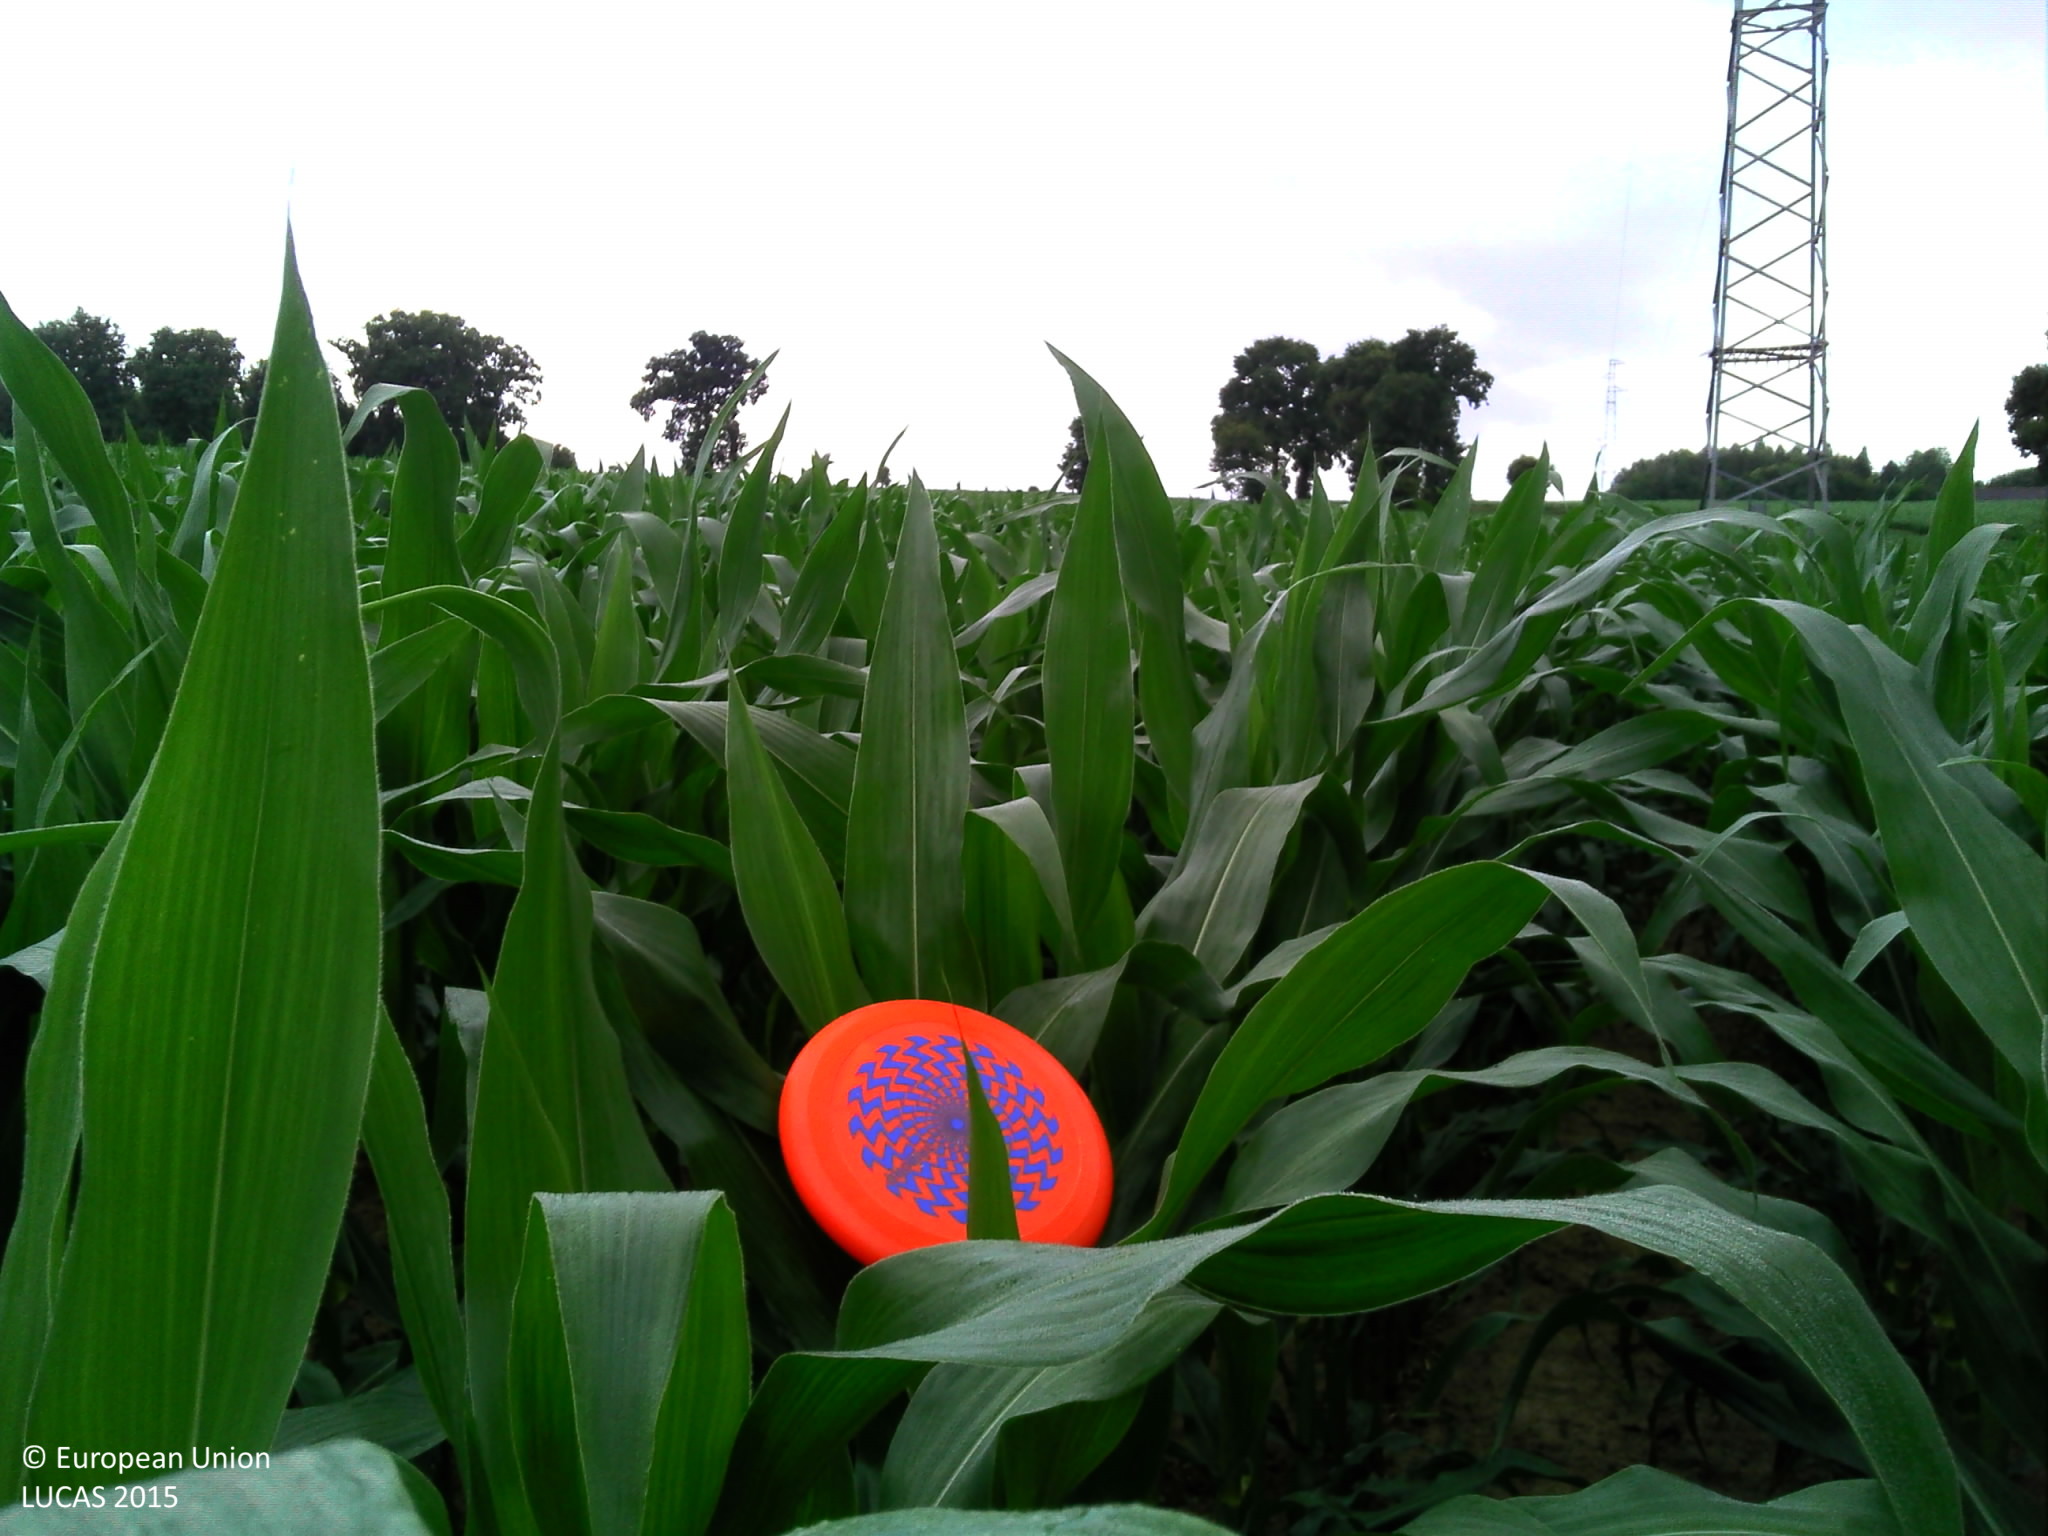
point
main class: Cropland
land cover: Maize
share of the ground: > 75 %
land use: Agriculture (excluding fallow land and kitchen gardens)
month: July
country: FR
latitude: 48.4898
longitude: -2.1942
